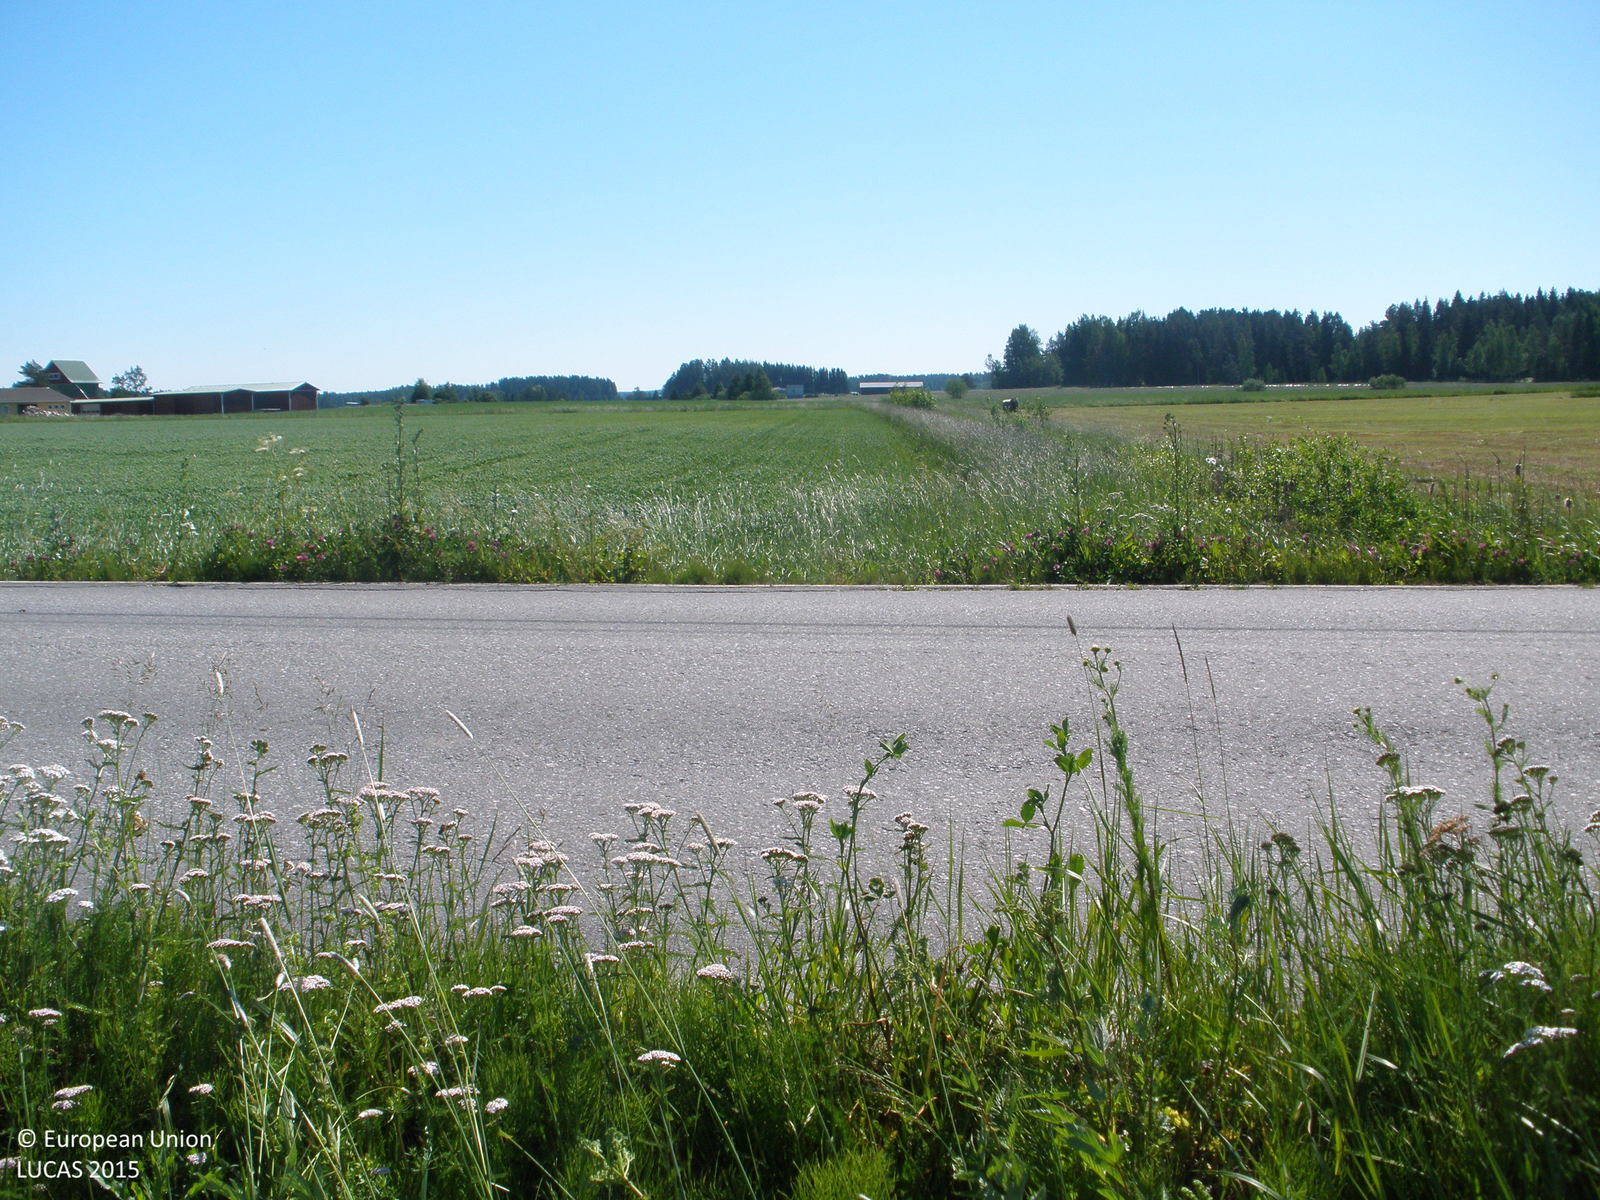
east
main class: Cropland
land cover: Floriculture and ornamental plants
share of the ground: > 75 %
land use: Agriculture (excluding fallow land and kitchen gardens)
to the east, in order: Floriculture and ornamental plants; Grass margins; Electric lines; Ditches and canals; Paved roads, cycling and walking lanes; Grass margins; Ditches and canals; Electric lines; Grass margins; Oats; Grass margins; Ditches and canals; Grass margins; Dry pulses
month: July
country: FI
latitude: 61.1489
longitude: 23.5898
